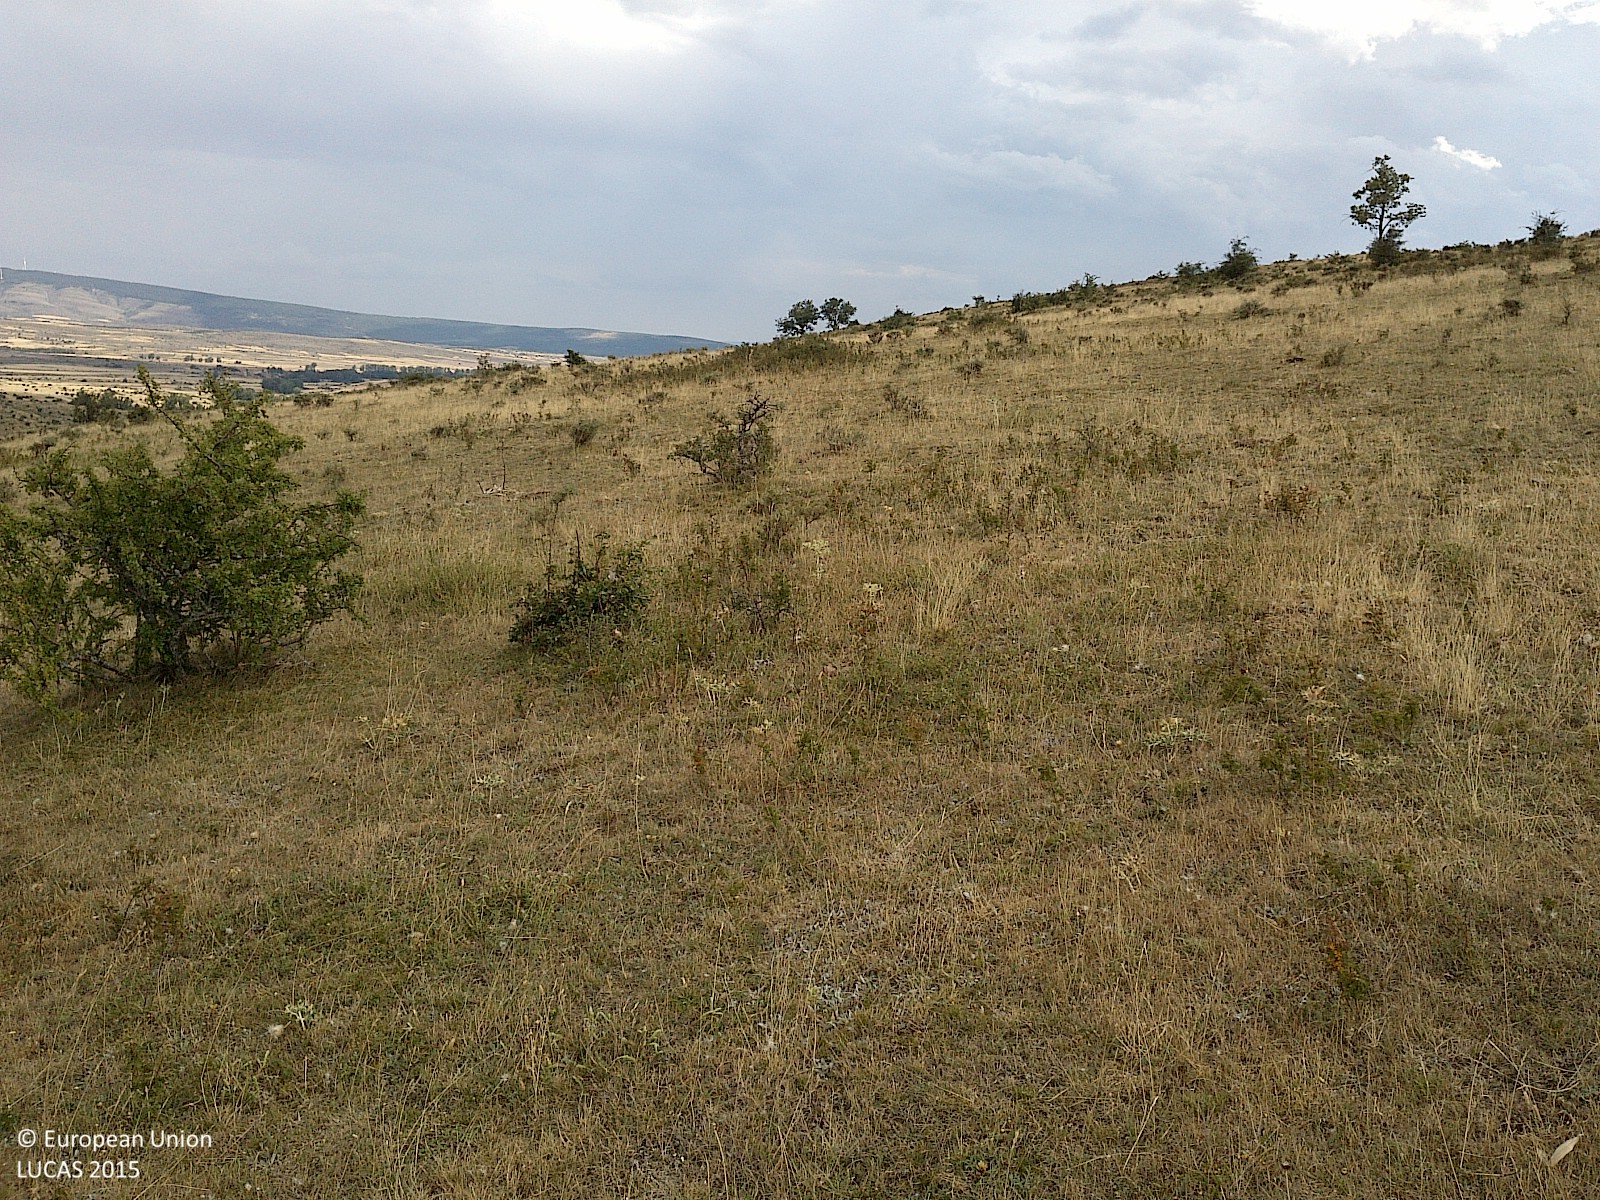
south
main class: Grassland
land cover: Grassland without tree/shrub cover
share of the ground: > 75 %
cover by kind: herbaceous plants 95 %, shrubs 5 %
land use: Agriculture (excluding fallow land and kitchen gardens)
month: July
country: ES
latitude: 41.9344
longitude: -2.3277
